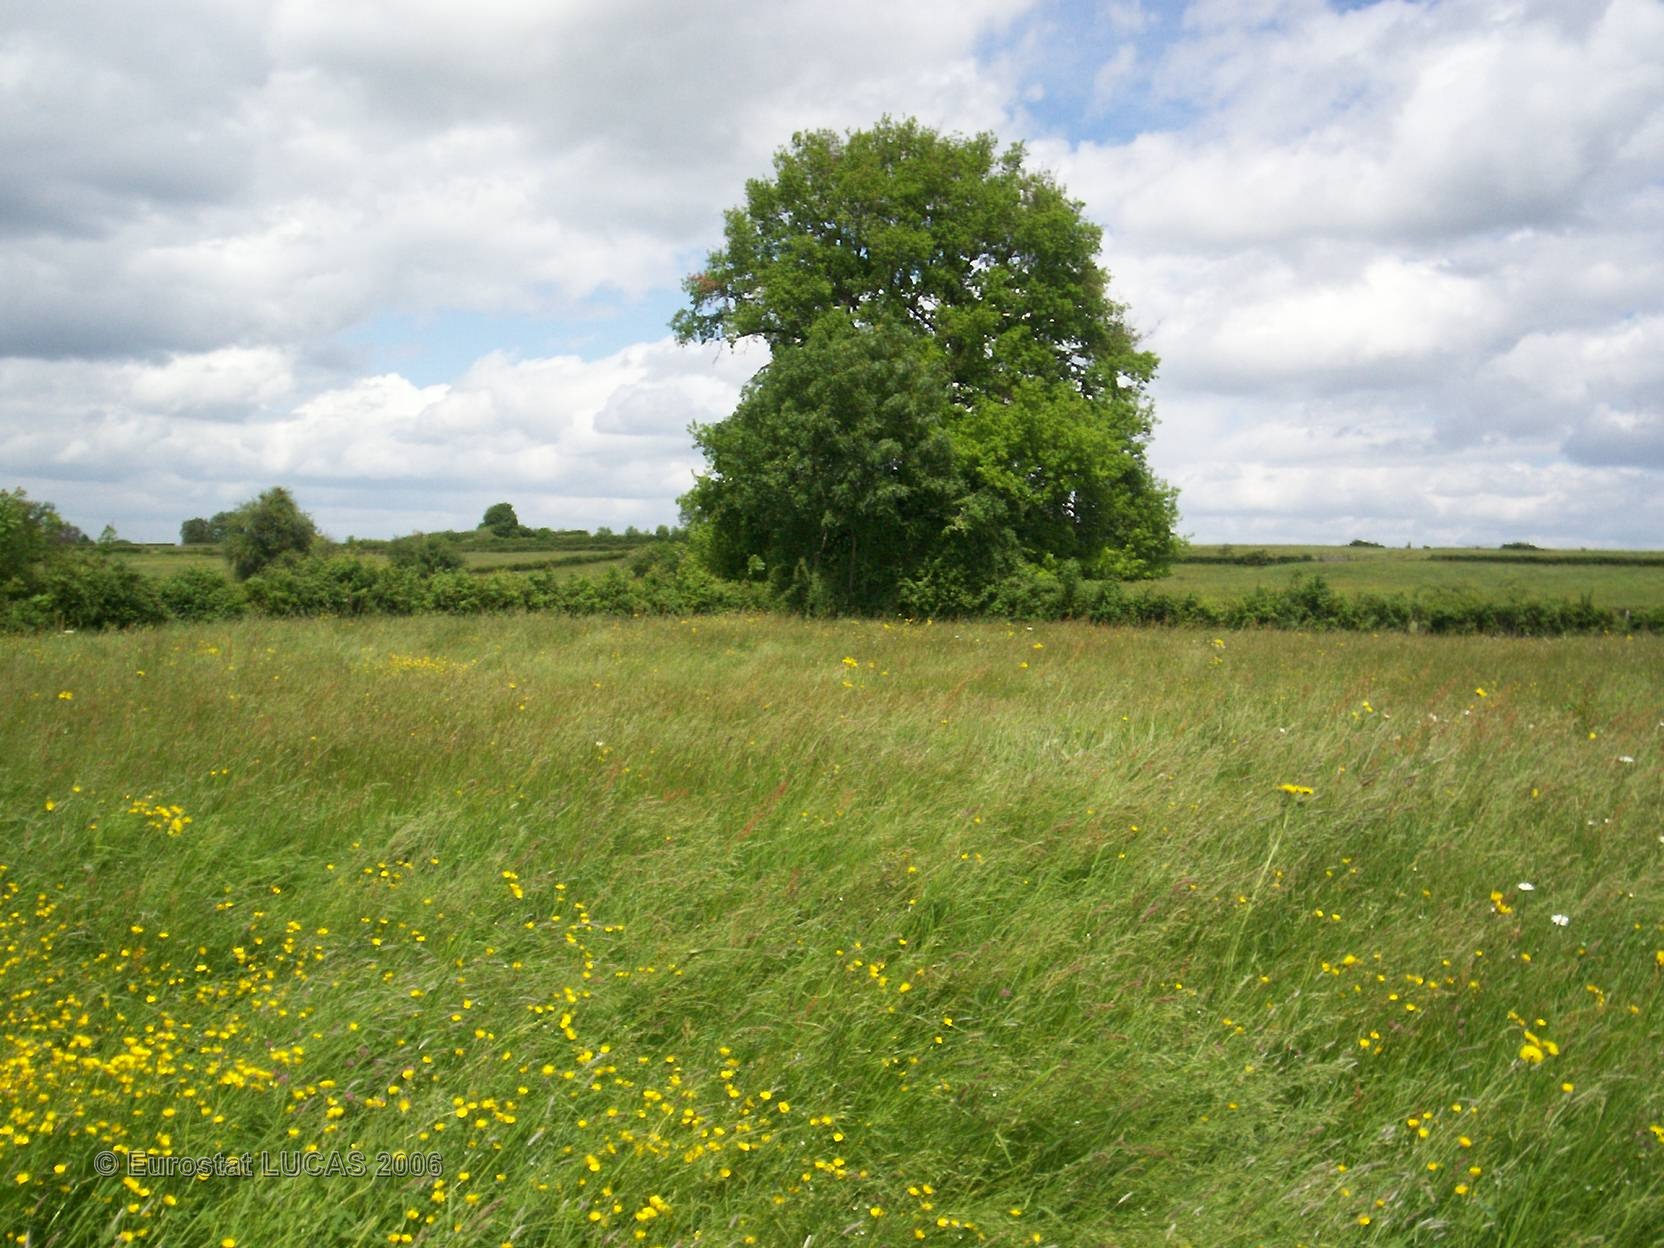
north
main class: Grassland
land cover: Grassland without tree/shrub cover
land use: Agriculture (excluding fallow land and kitchen gardens)
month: May
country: FR
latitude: 47.0638
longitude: 4.6150
